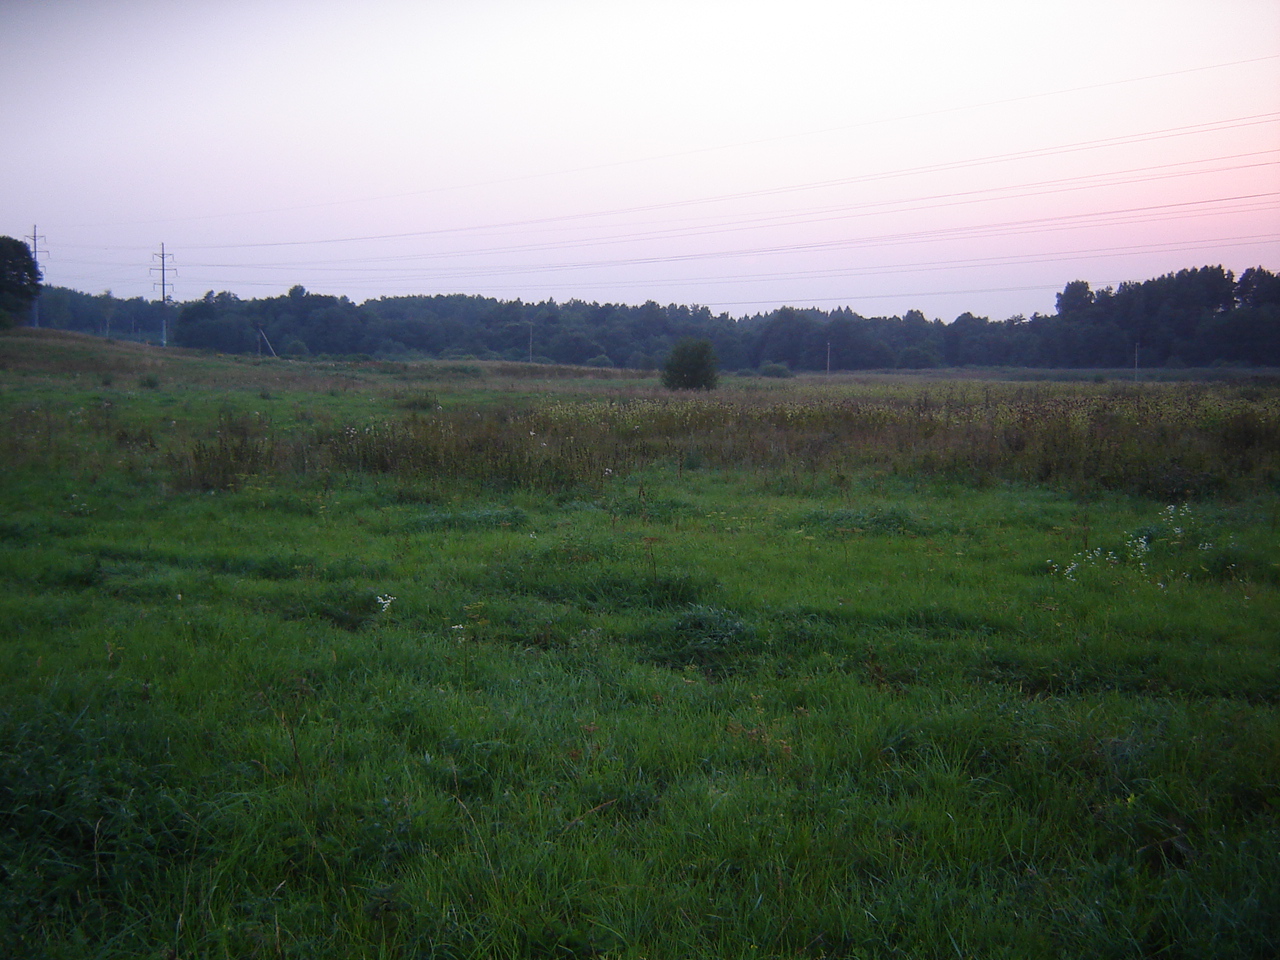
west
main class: Grassland
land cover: Grassland without tree/shrub cover
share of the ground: > 75 %
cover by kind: herbaceous plants 100 %
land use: Agriculture (excluding fallow land and kitchen gardens)
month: August
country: LT
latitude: 54.7989
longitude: 25.1917
